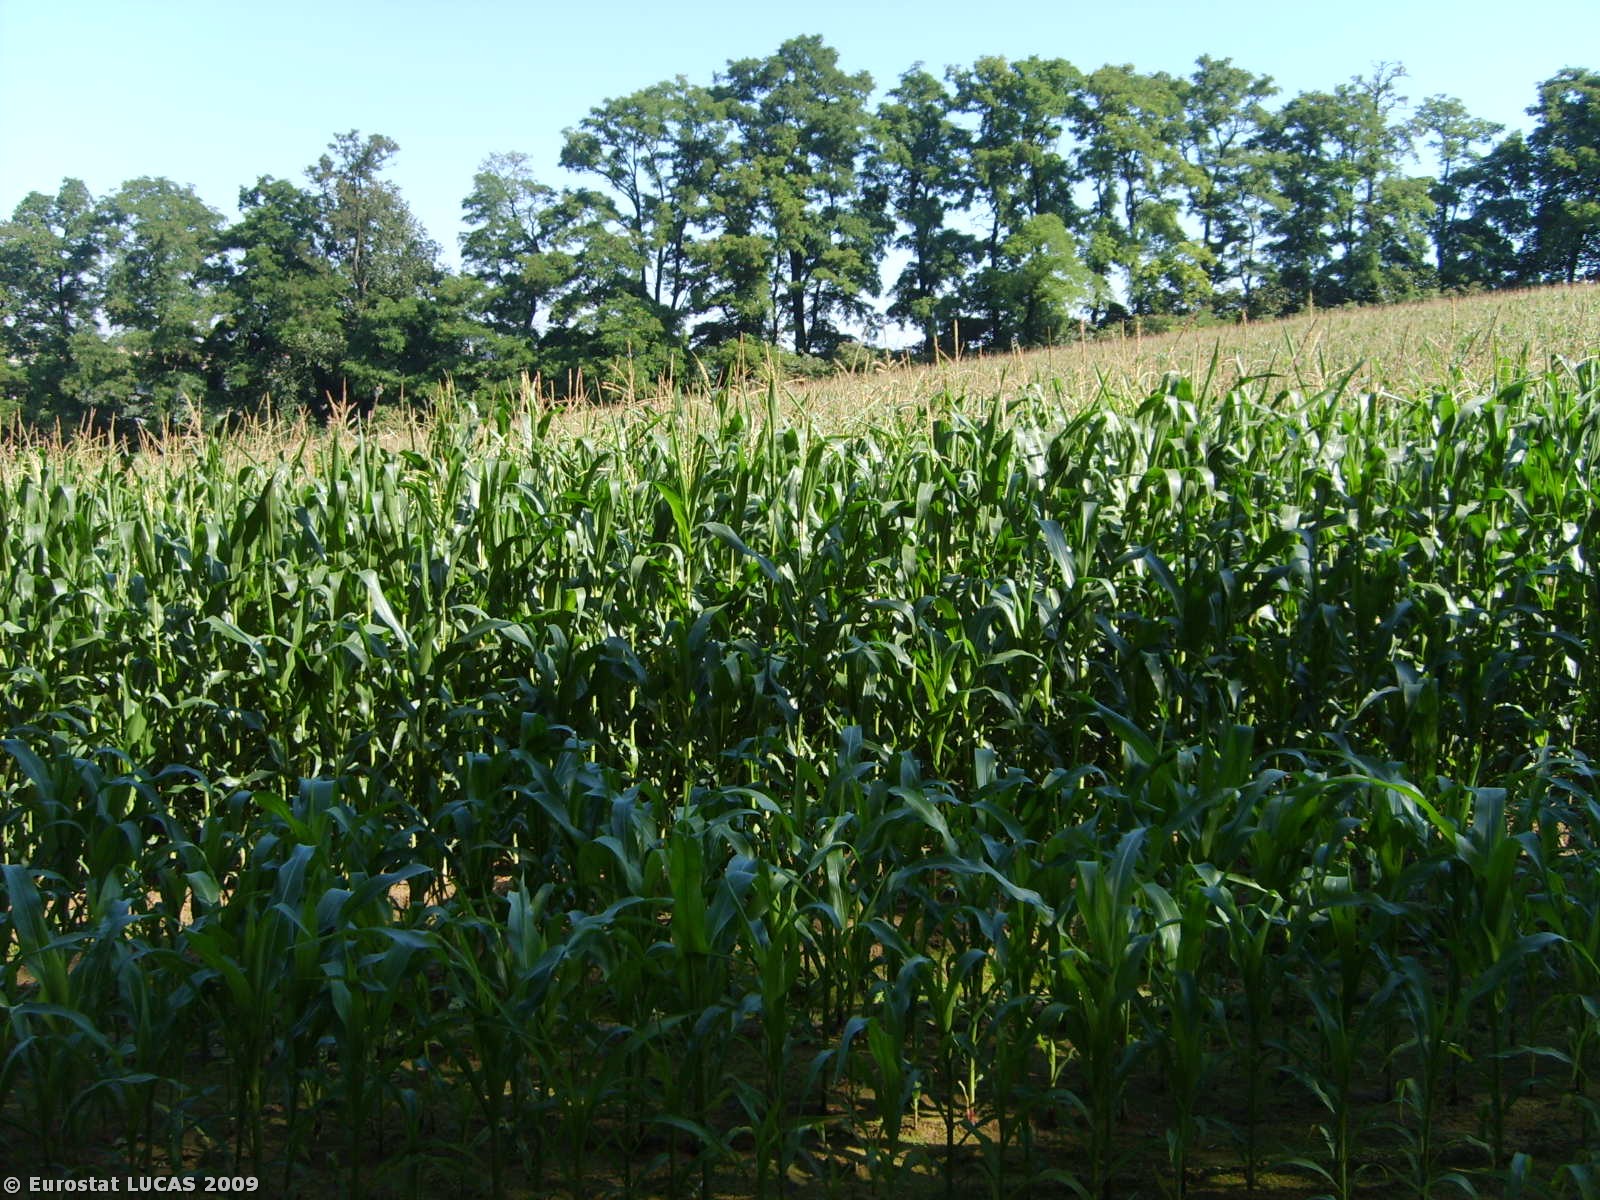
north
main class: Cropland
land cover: Maize
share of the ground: 50 - 75 %
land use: Agriculture (excluding fallow land and kitchen gardens)
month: July
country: PL
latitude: 50.1572
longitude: 20.2386
